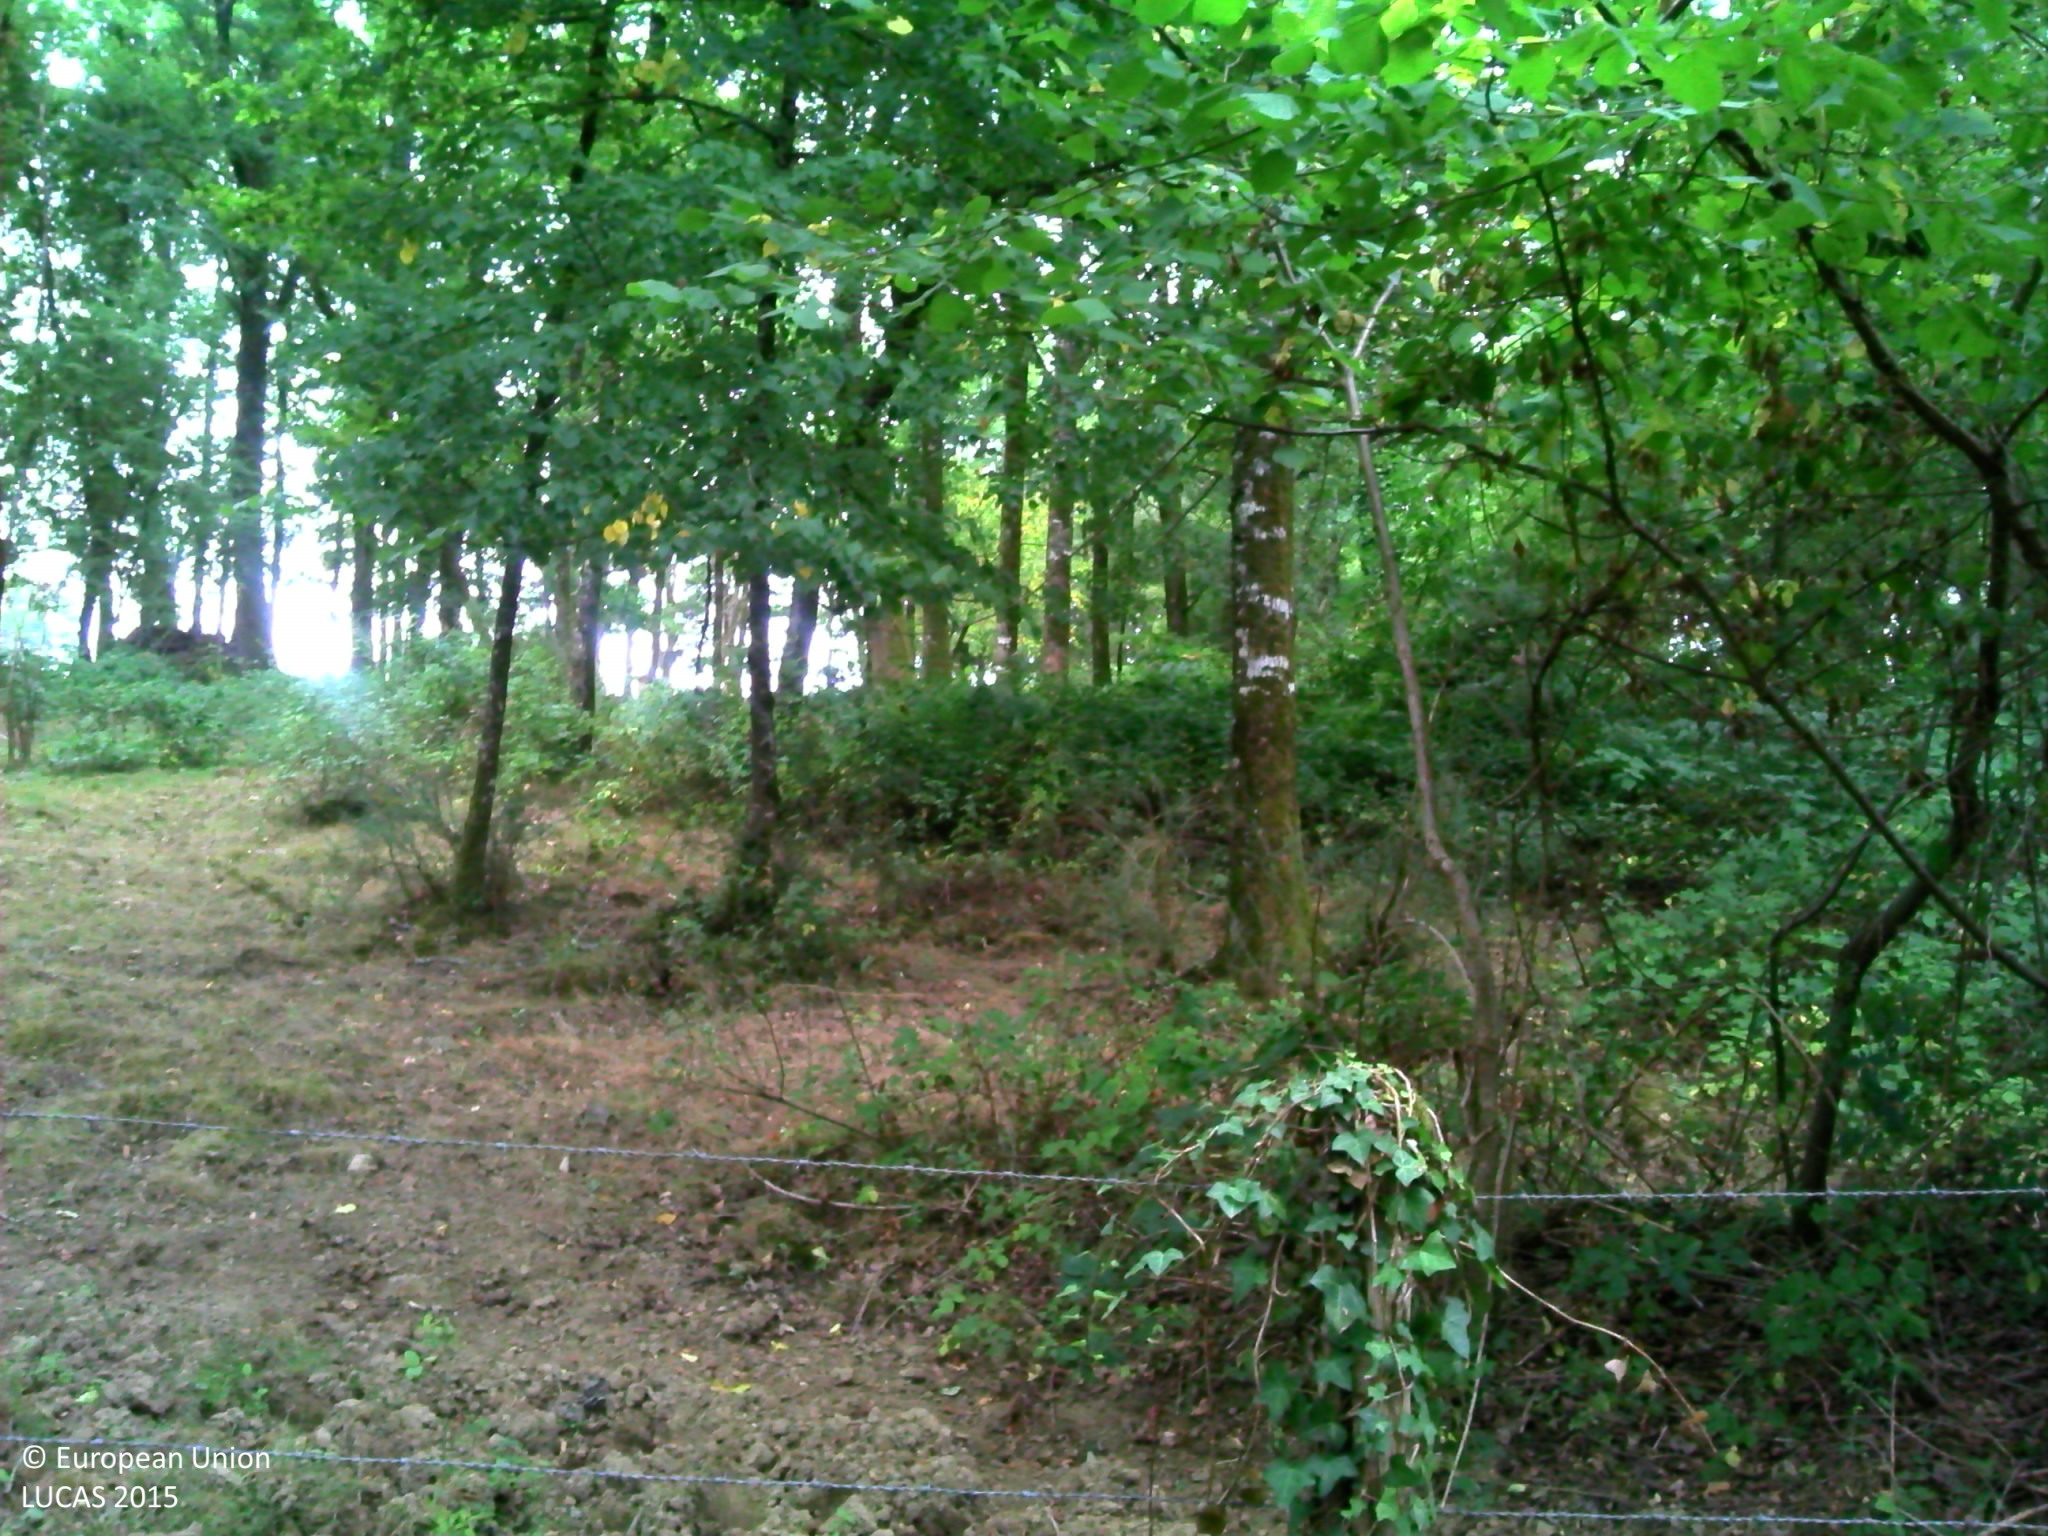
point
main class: Woodland
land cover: Broadleaved woodland
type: mesophytic deciduous forest
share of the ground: > 75 %
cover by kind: broadleaved forest trees 70 %, herbaceous plants 20 %, lichens and mosses 5 %, unconsolidated bare surface 5 %
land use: Forestry
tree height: > 5 m
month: July
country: FR
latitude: 45.5288
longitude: 0.7054
